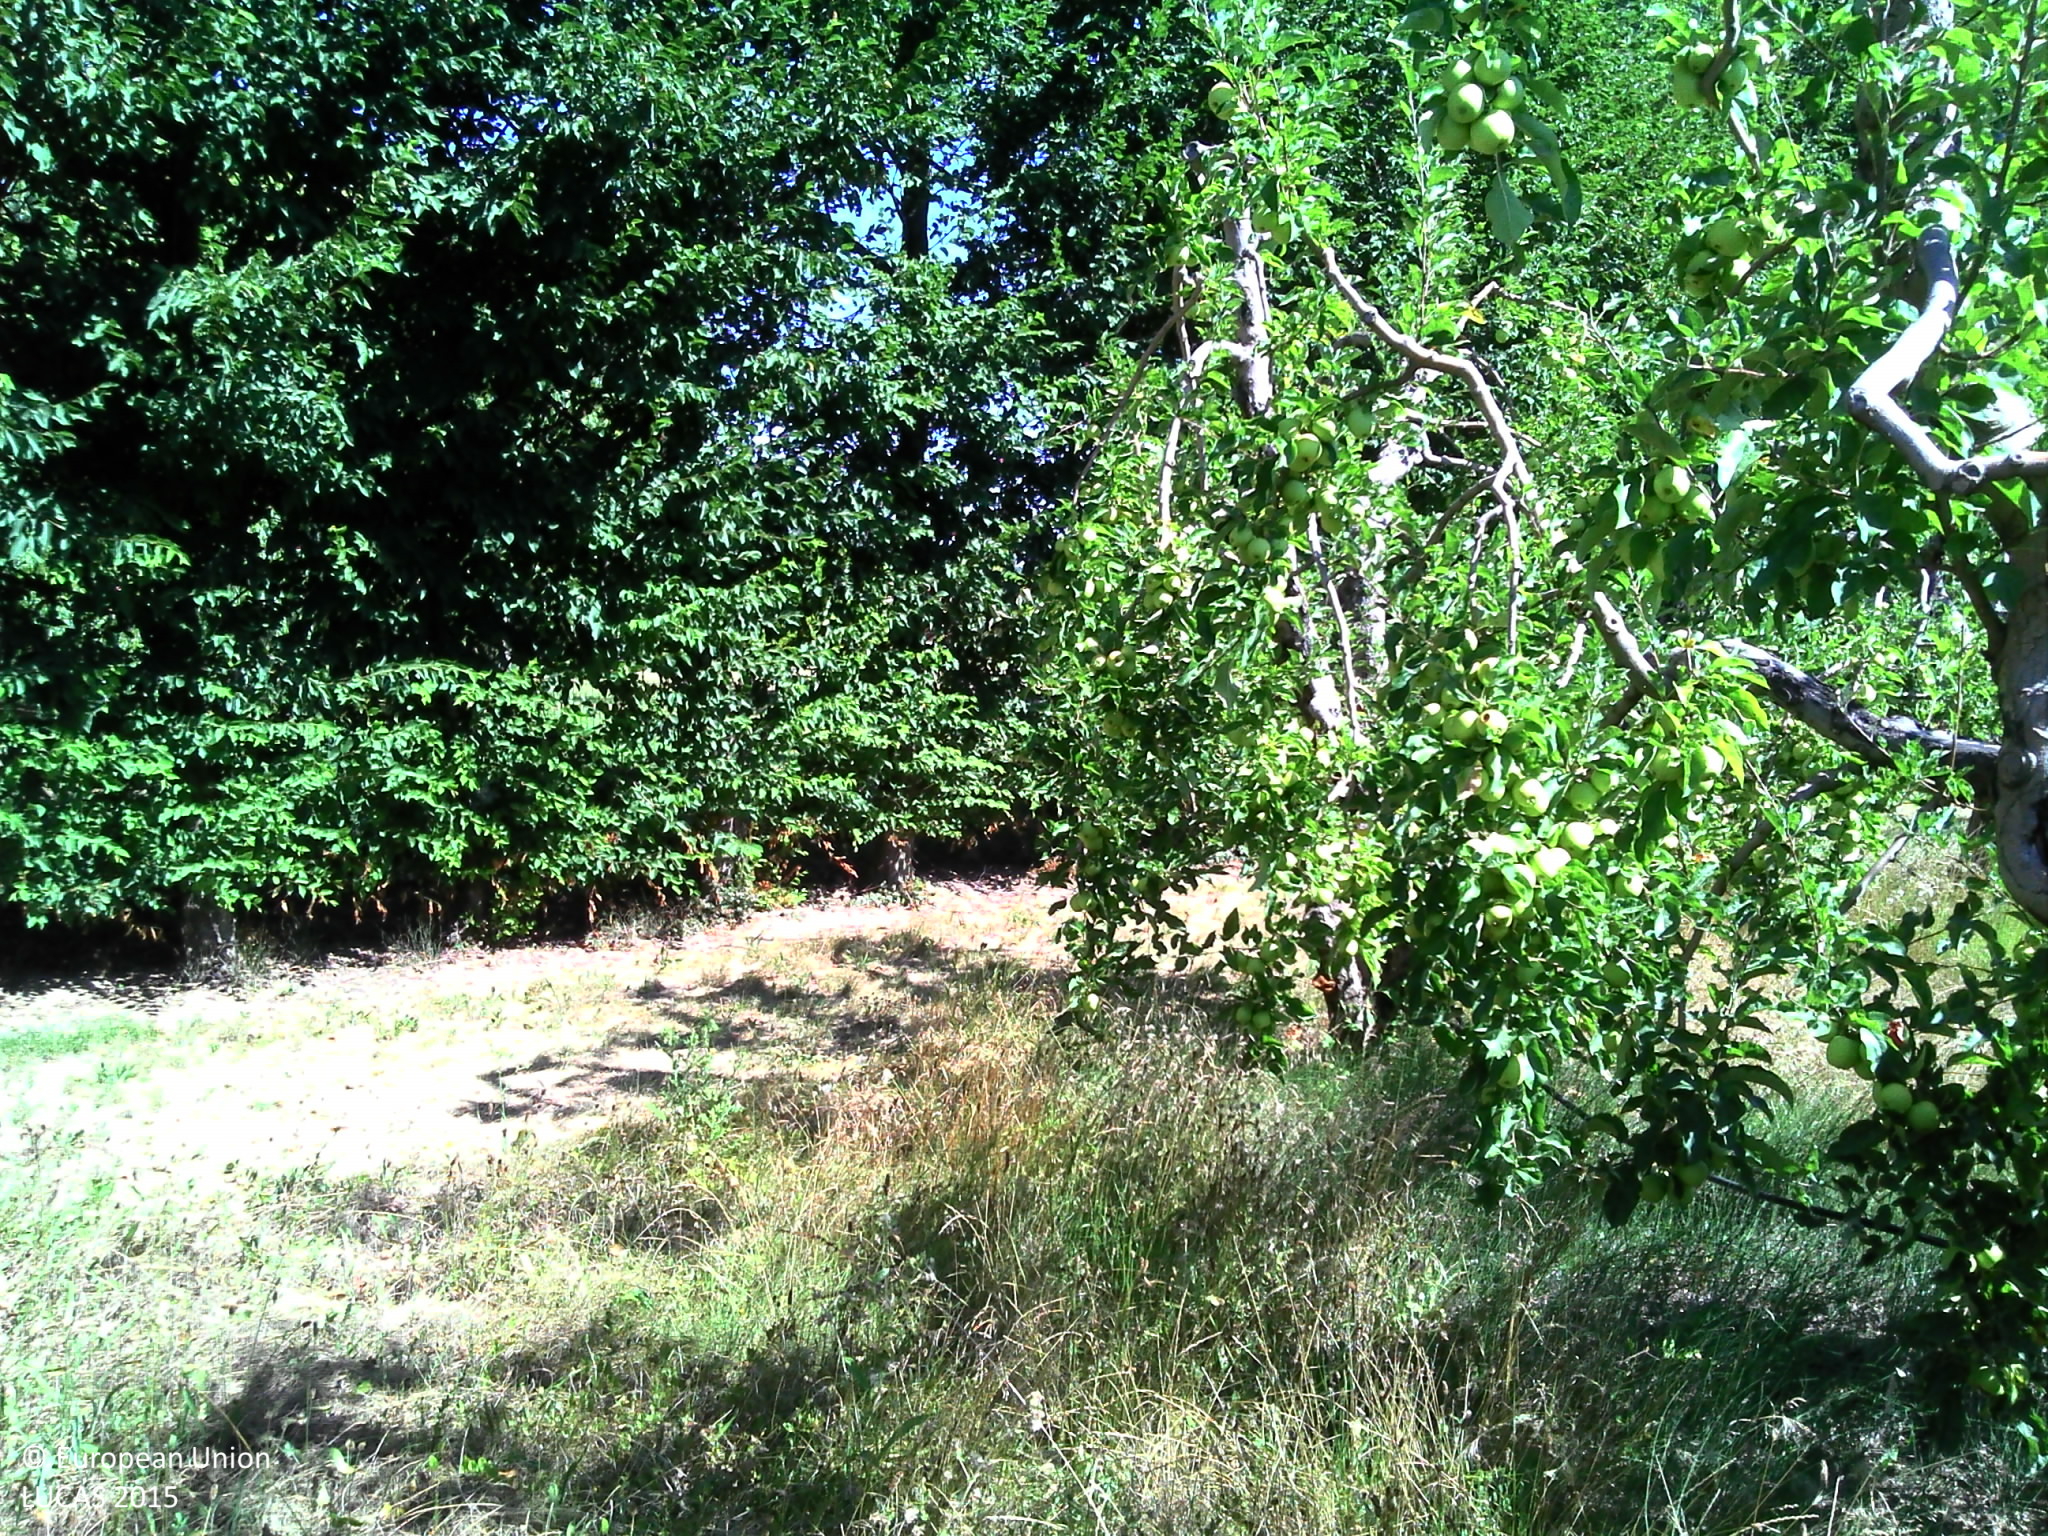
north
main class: Cropland
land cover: Apple fruit
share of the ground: 50 - 75 %
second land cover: Grassland without tree/shrub cover
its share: 50 - 75 %
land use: Agriculture (excluding fallow land and kitchen gardens)
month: July
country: FR
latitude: 43.8539
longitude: 5.0700
